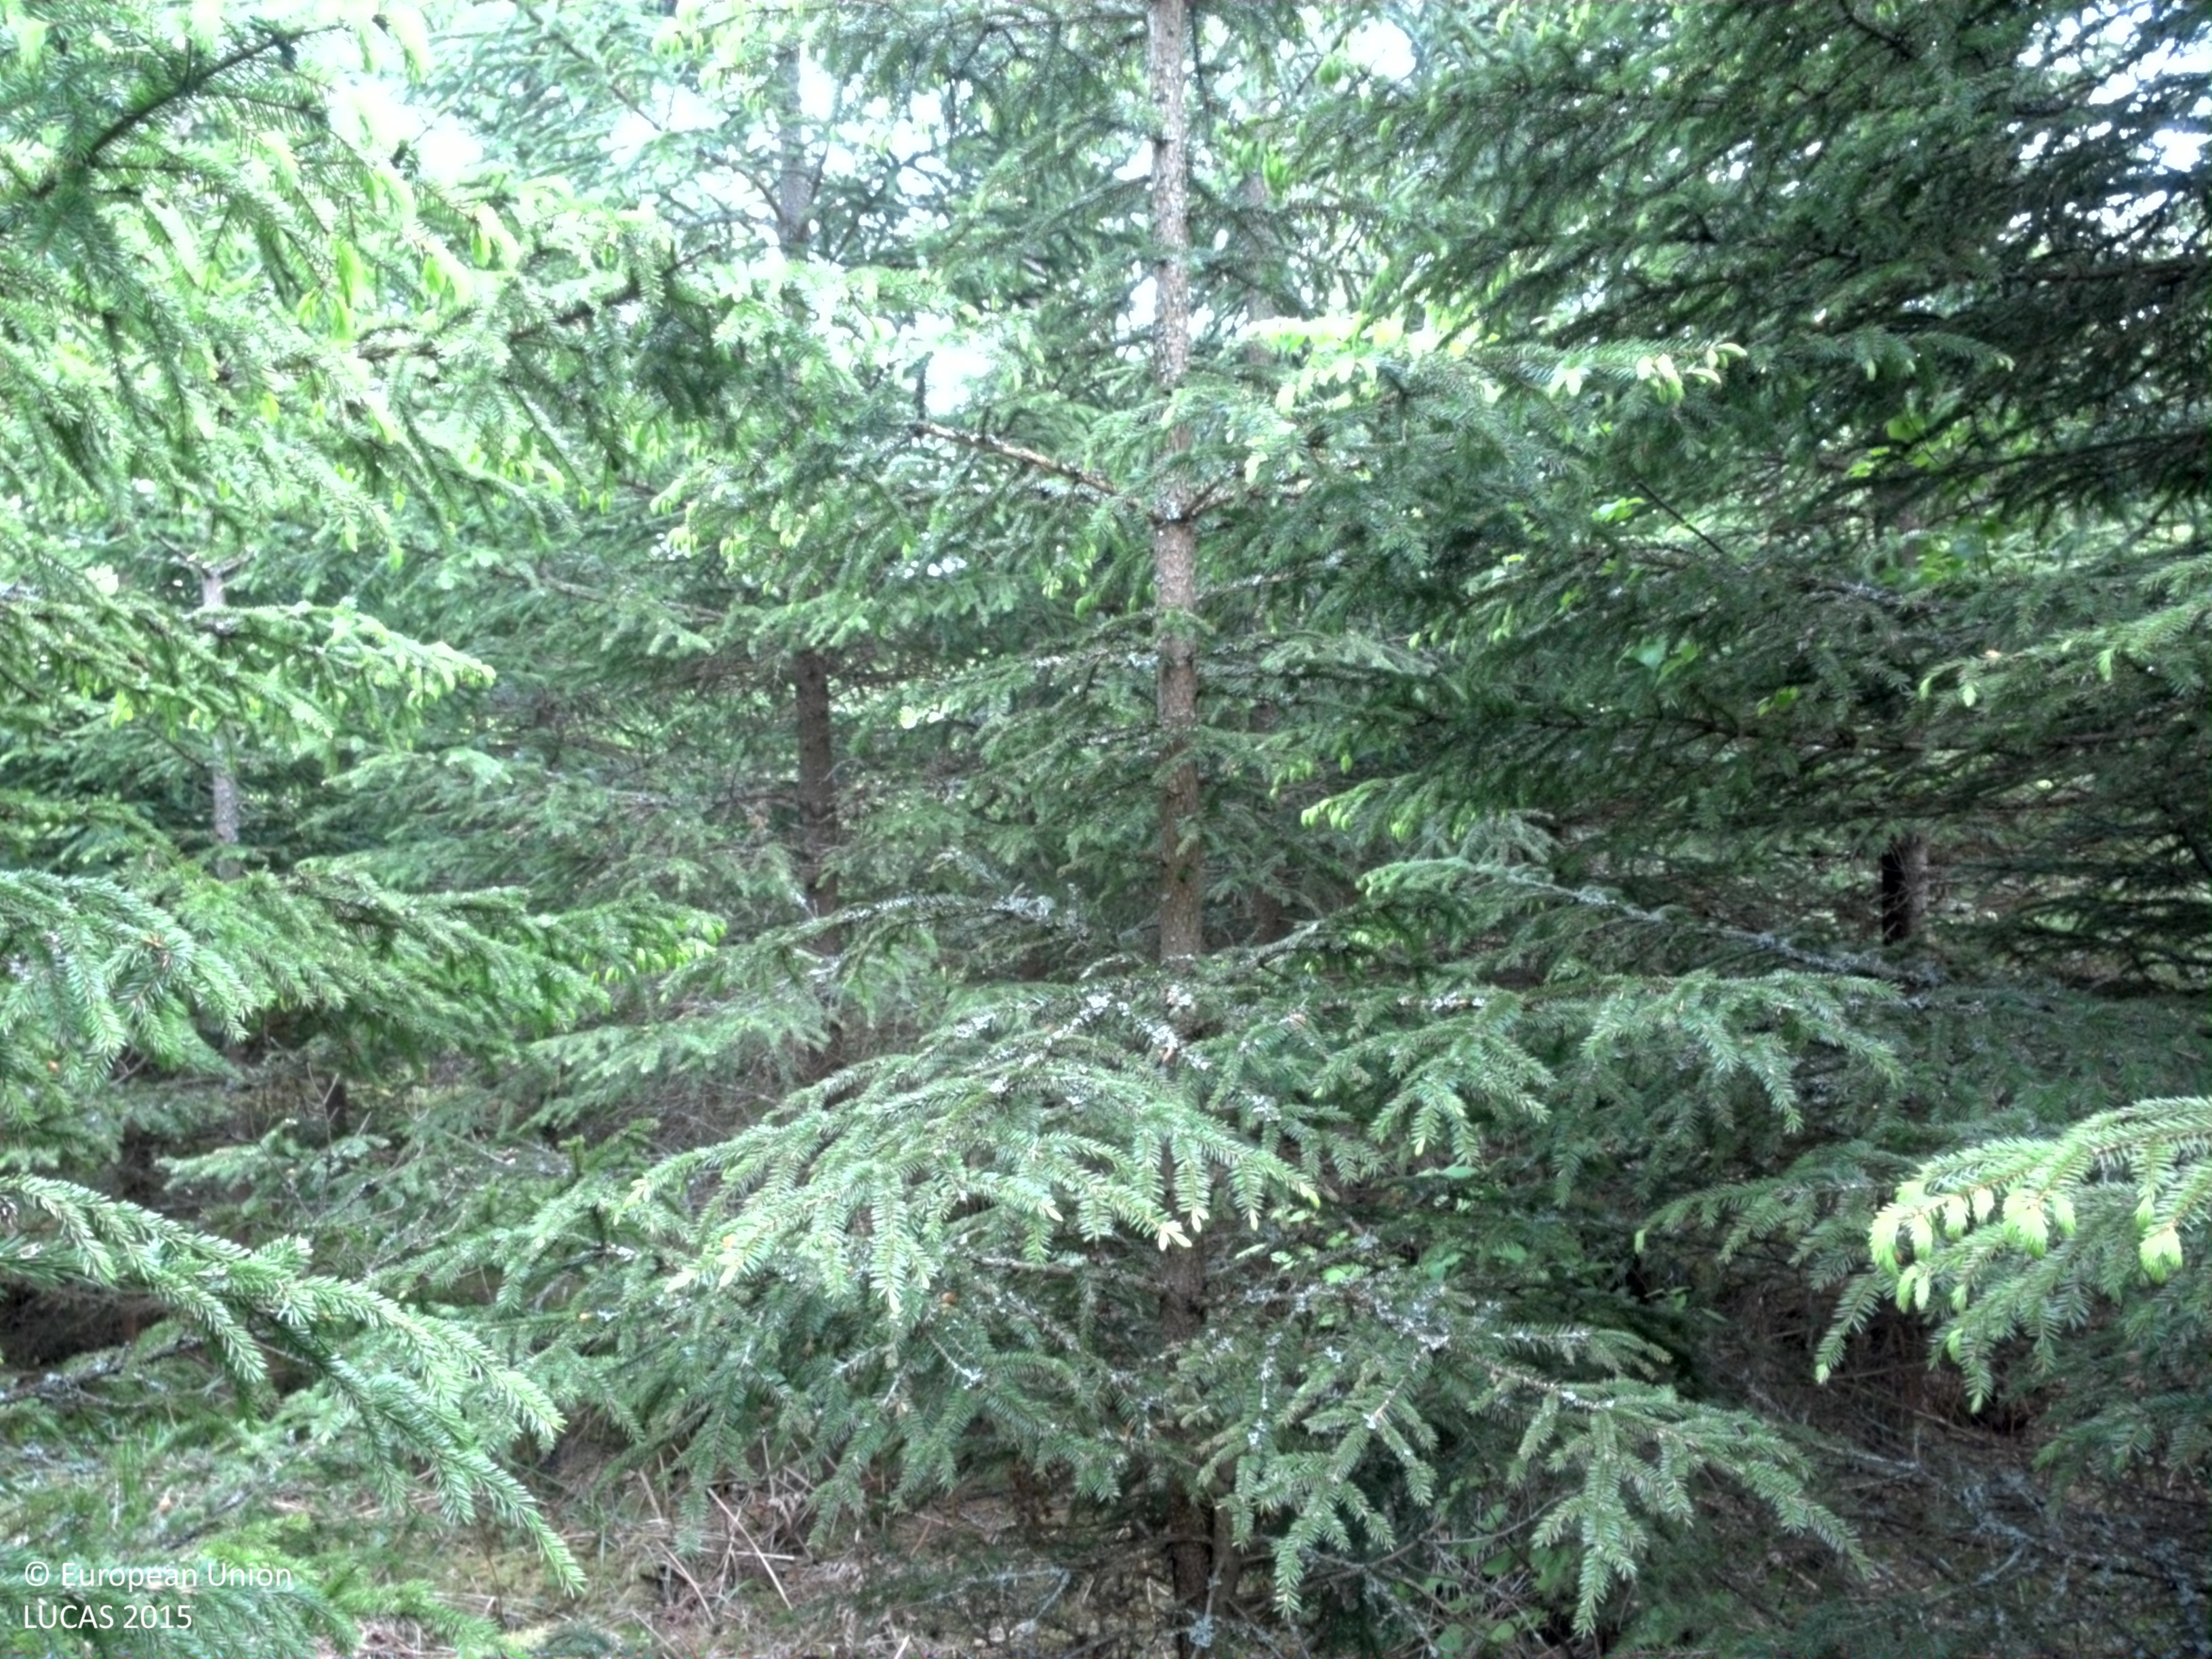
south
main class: Woodland
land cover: Spruce dominated coniferous woodland
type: boreal forest
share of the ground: 50 - 75 %
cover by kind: coniferous forest trees 60 %, broadleaved forest trees 10 %, shrubs 10 %, herbaceous plants 10 %, lichens and mosses 10 %
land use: Forestry
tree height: > 5 m
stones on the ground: > 50 %
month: May
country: SE
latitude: 57.2565
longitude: 15.9827
